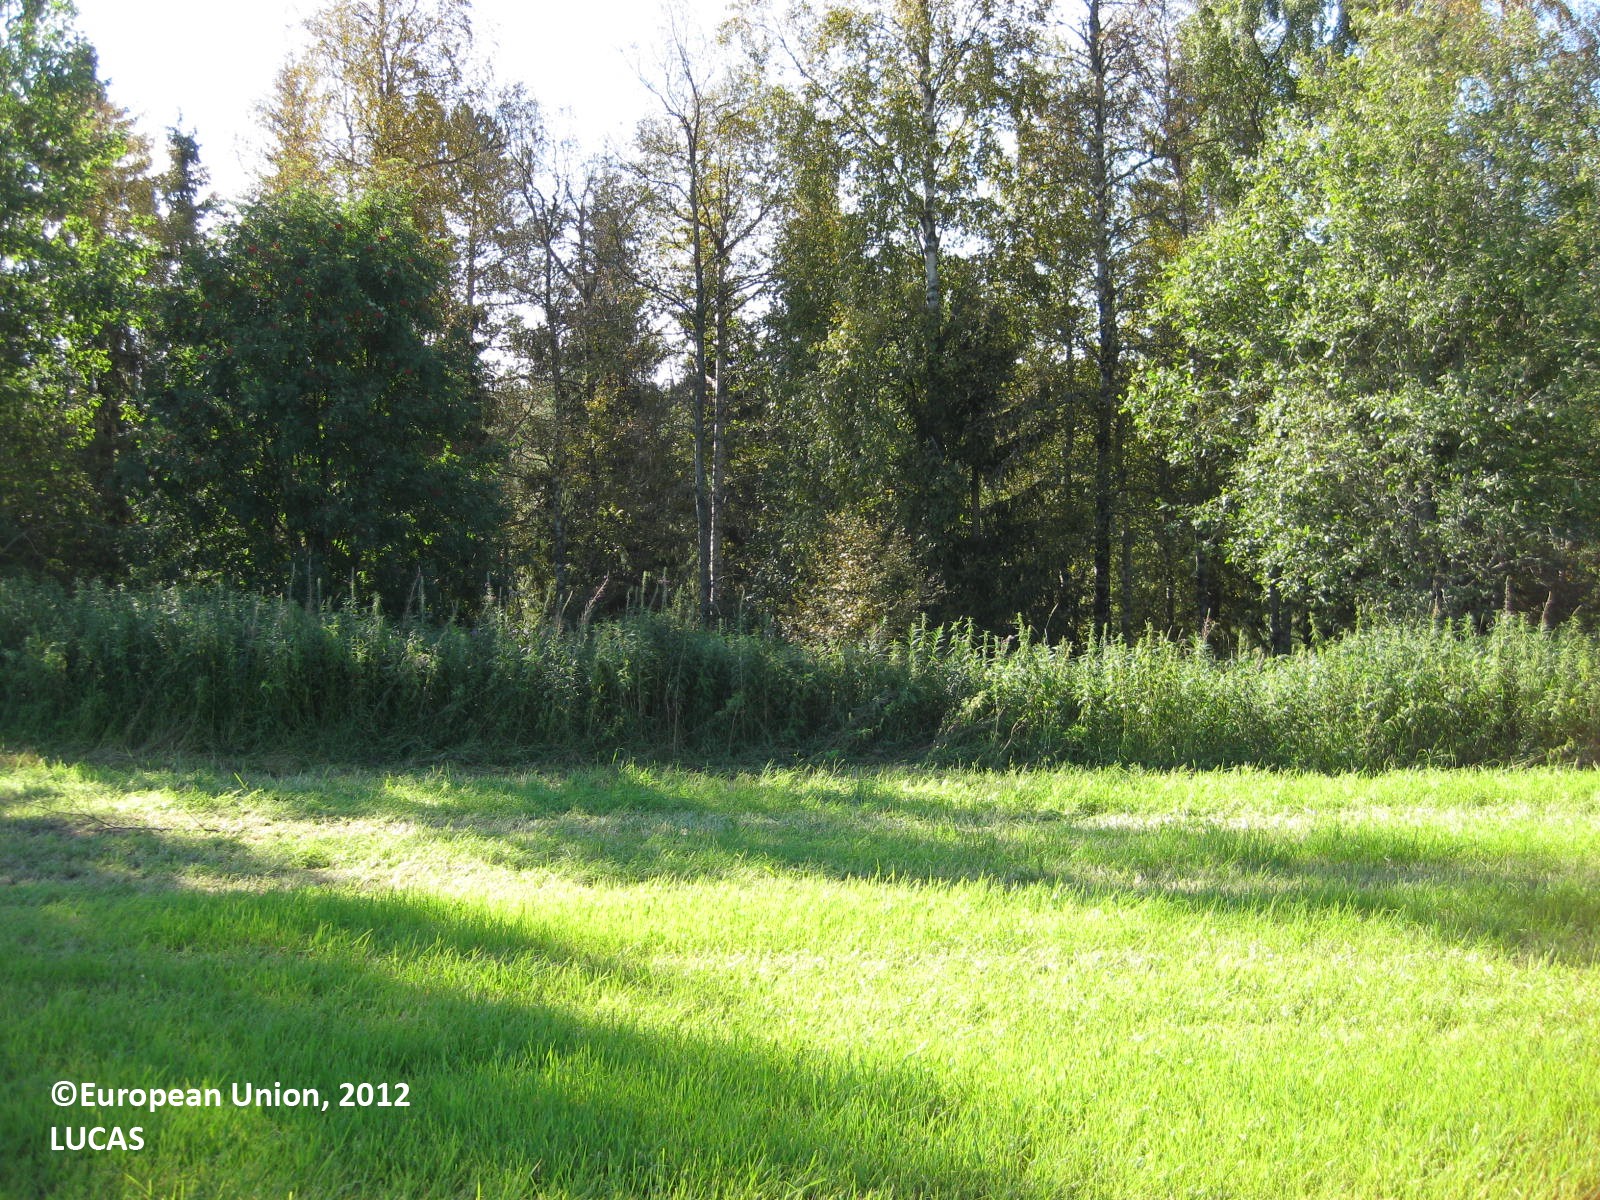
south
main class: Cropland
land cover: Temporary grasslands
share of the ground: > 75 %
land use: Agriculture (excluding fallow land and kitchen gardens)
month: August
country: FI
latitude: 66.0815
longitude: 29.6230
